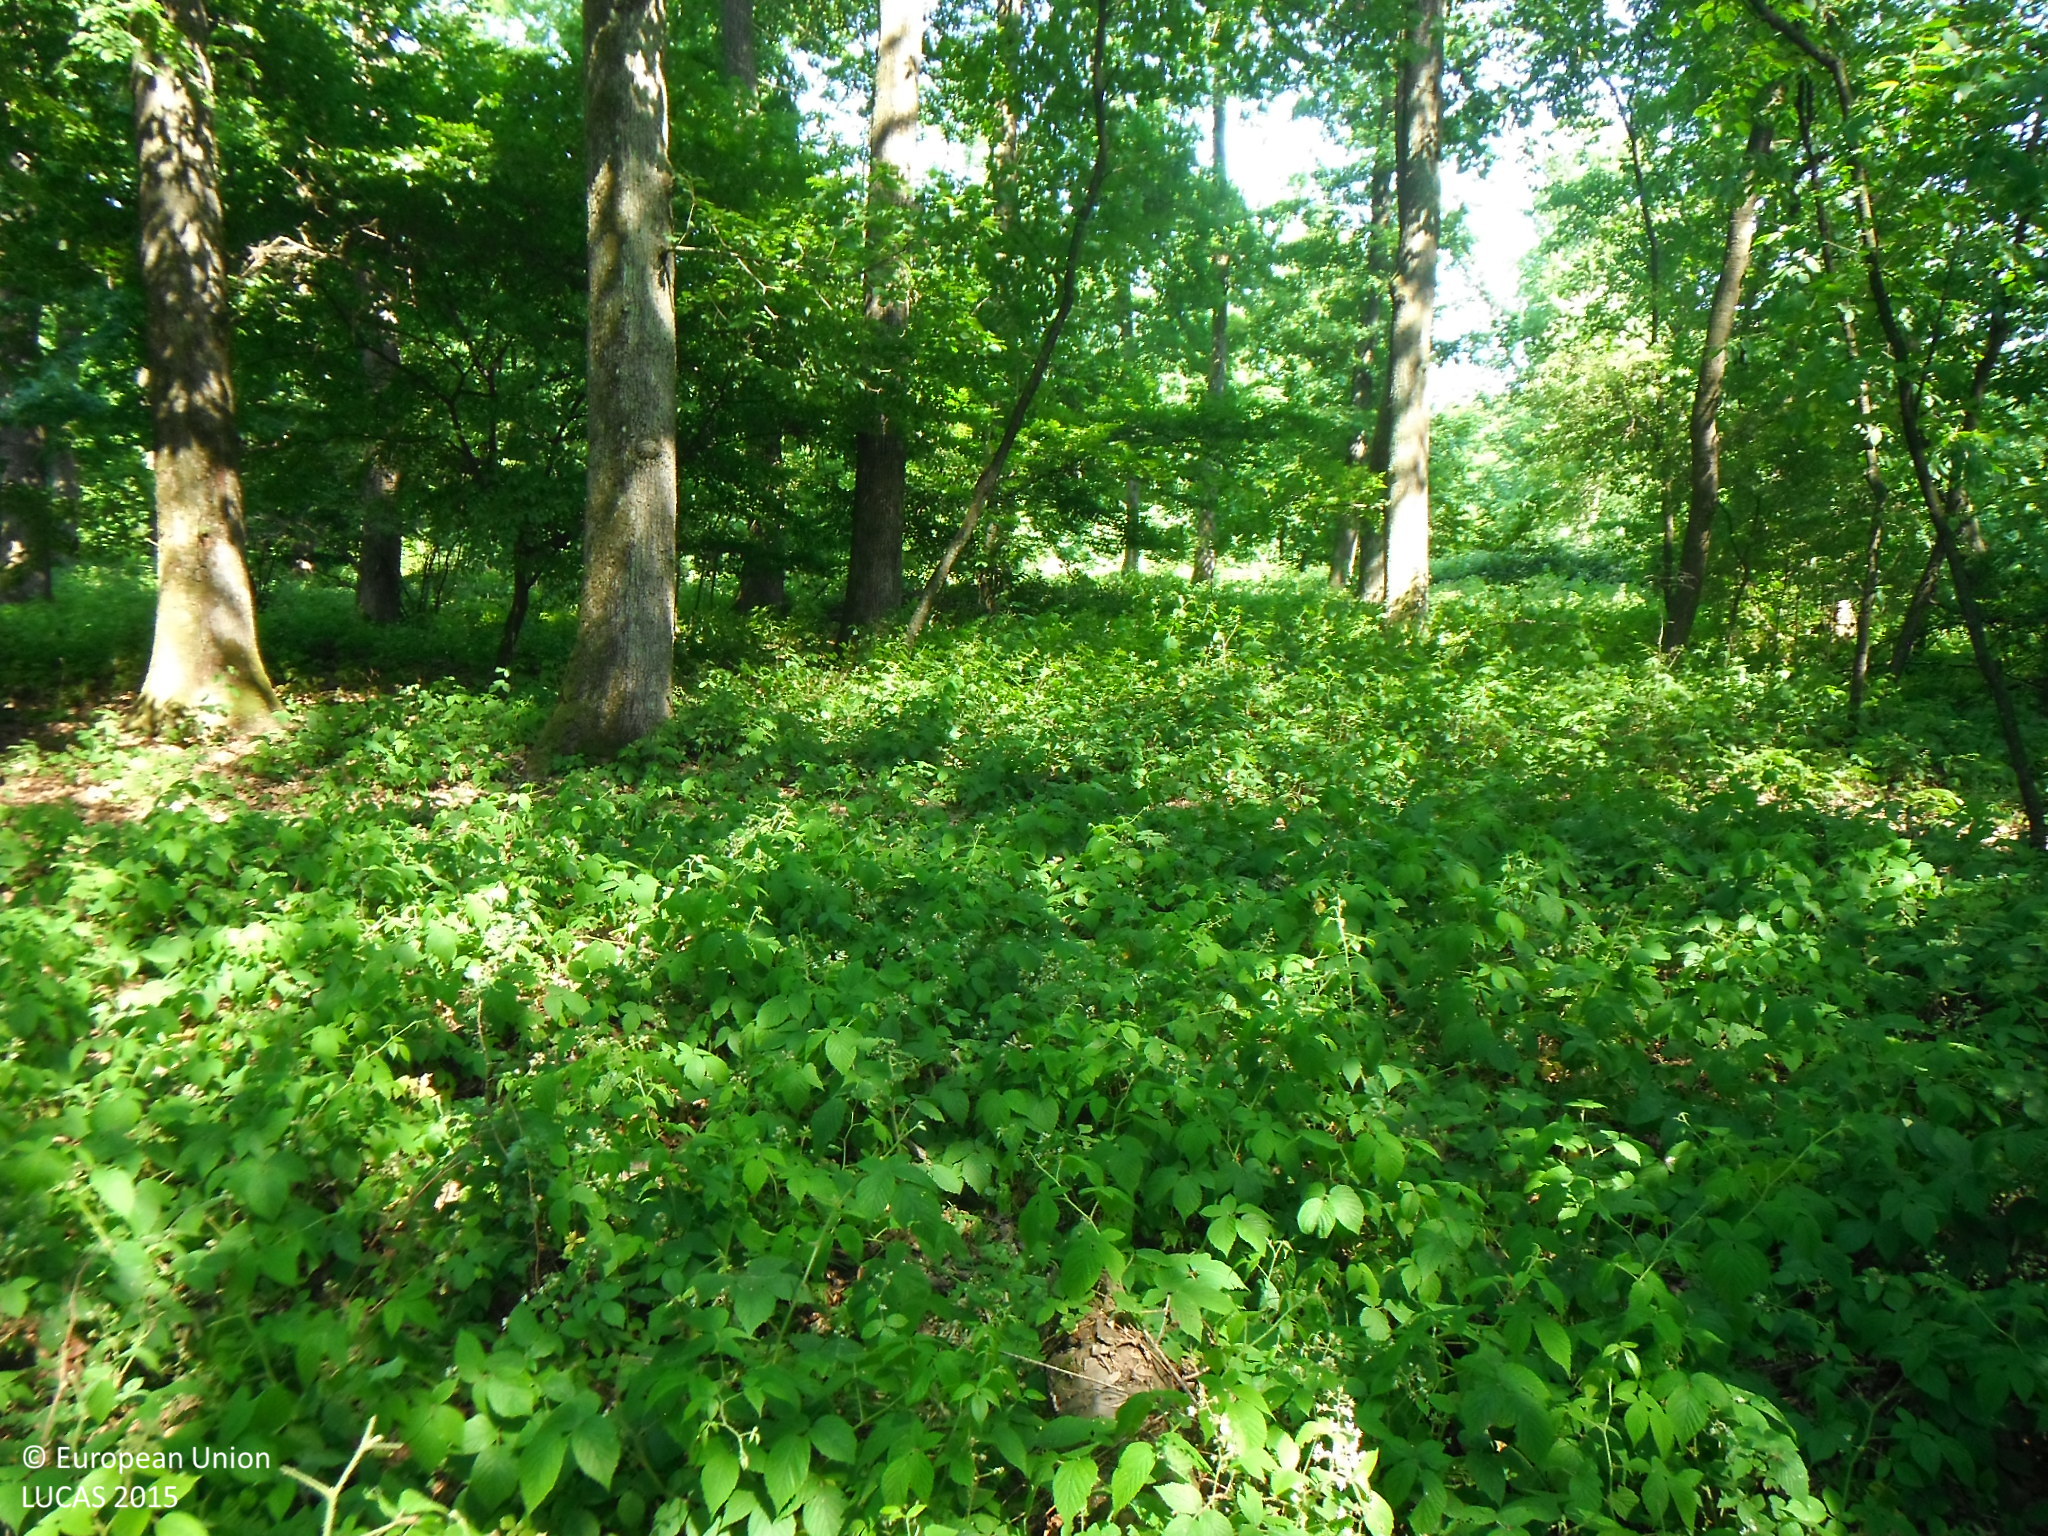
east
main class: Woodland
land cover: Broadleaved woodland
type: beech forest
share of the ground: > 75 %
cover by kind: broadleaved forest trees 80 %, herbaceous plants 20 %
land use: Forestry
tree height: > 5 m
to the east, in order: Broadleaved woodland; Tracks; Broadleaved woodland
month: June
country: SK
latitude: 48.7730
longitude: 21.9328
